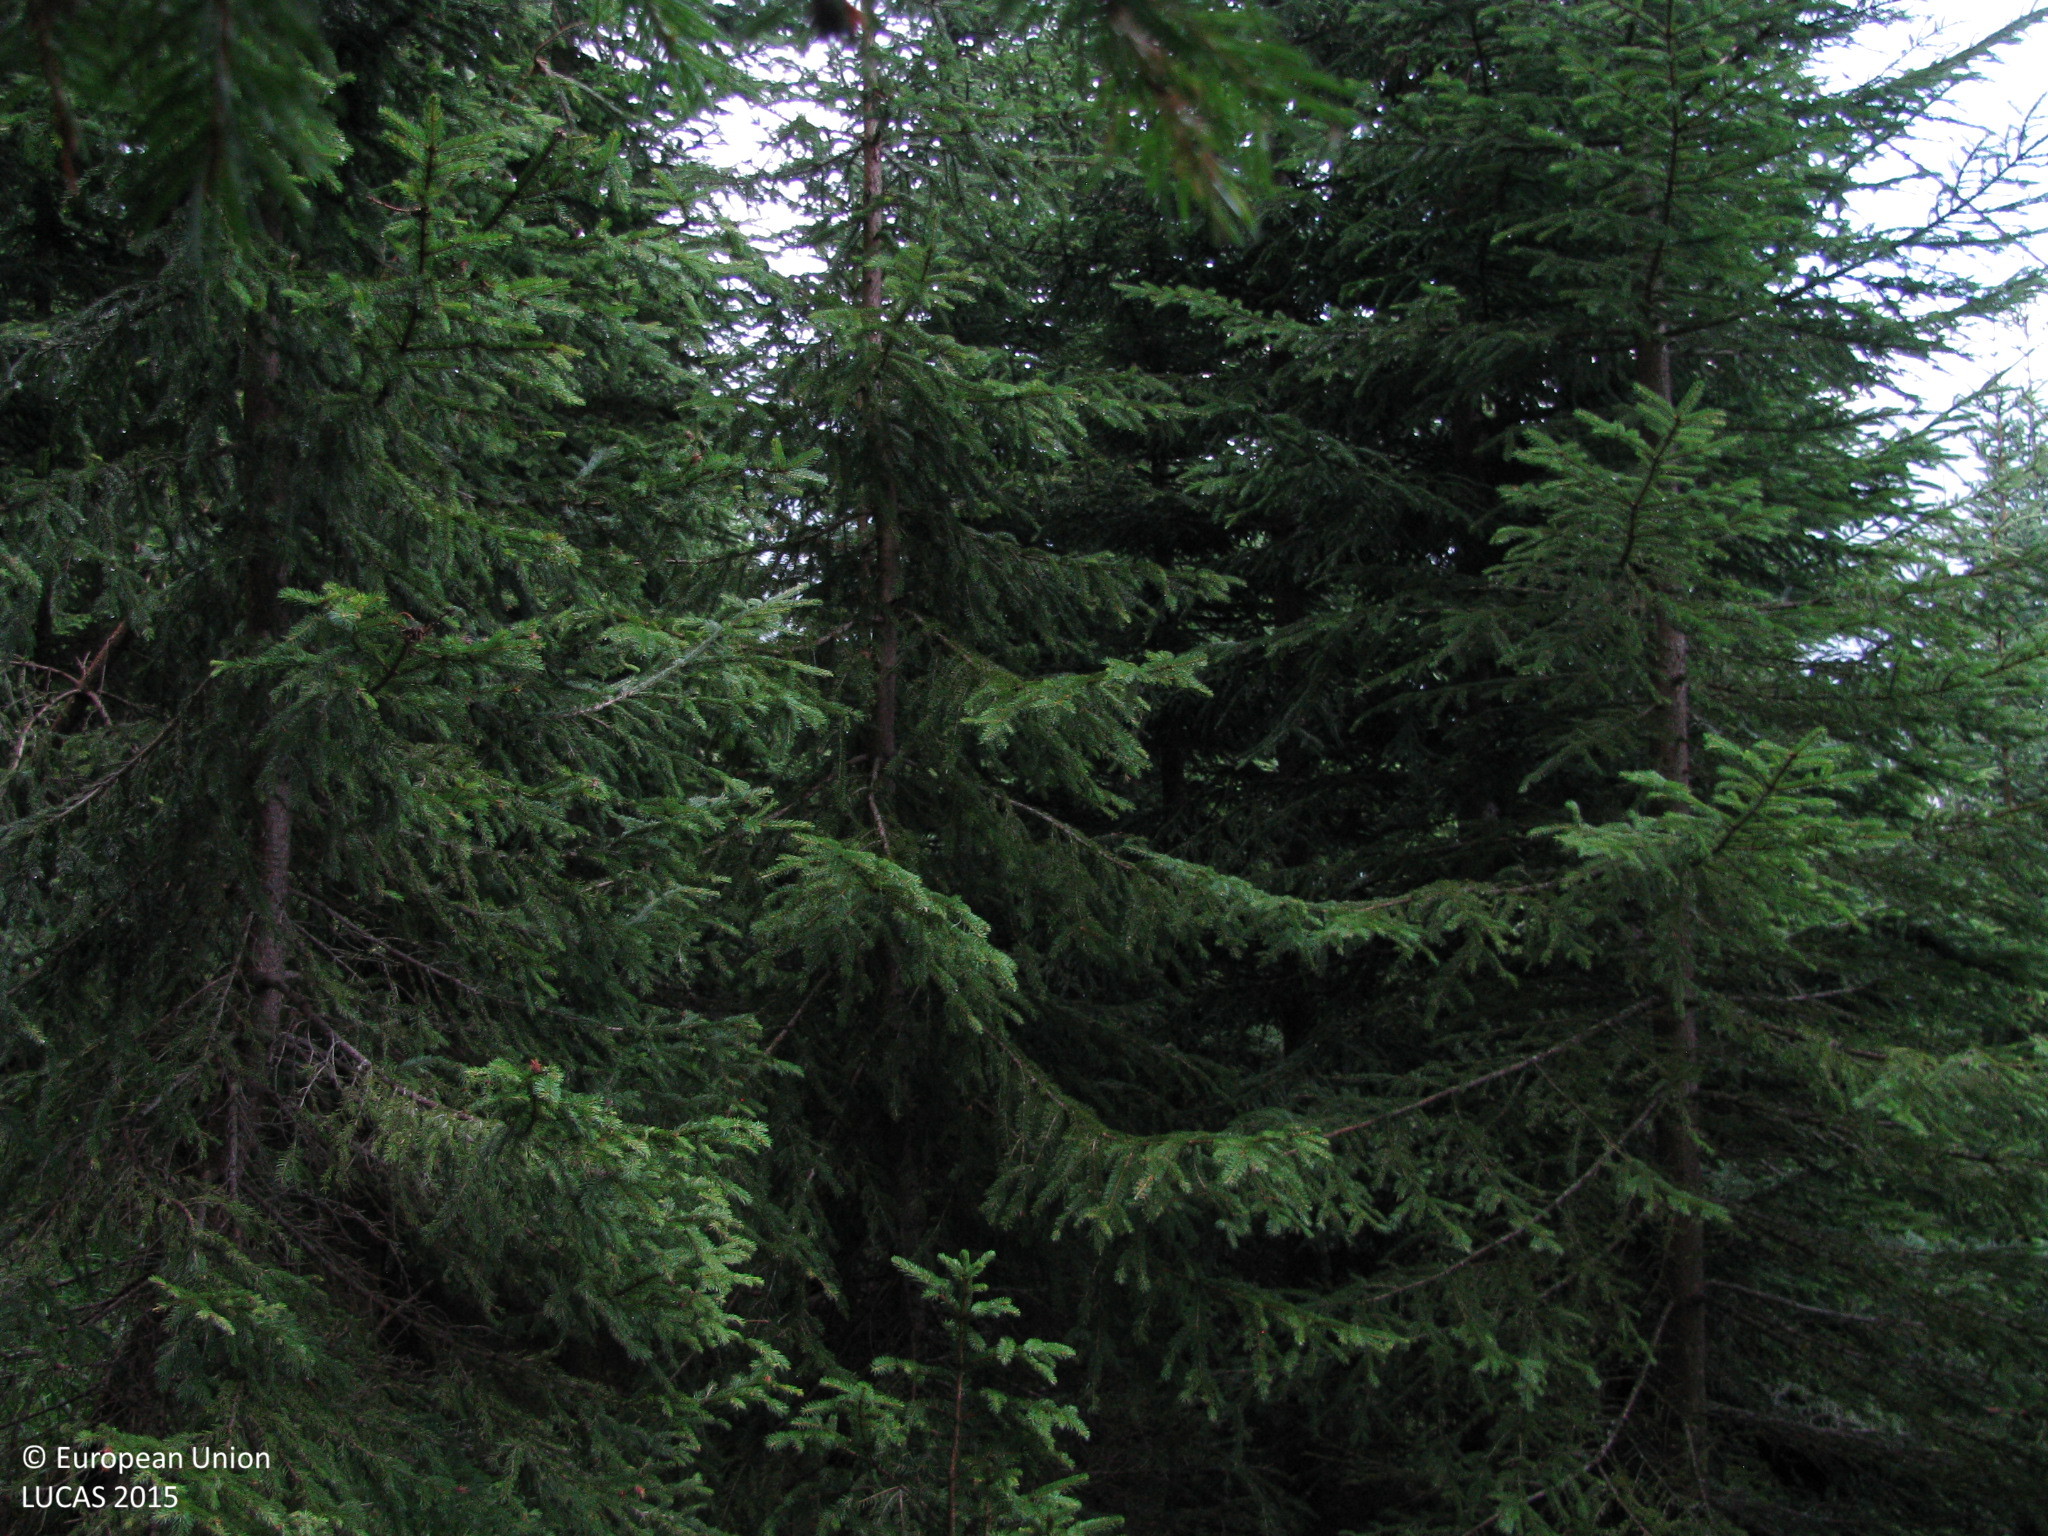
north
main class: Woodland
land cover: Spruce dominated coniferous woodland
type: alpine coniferous forest
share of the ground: > 75 %
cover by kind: coniferous forest trees 85 %, herbaceous plants 15 %
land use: Forestry
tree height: > 5 m
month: July
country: AT
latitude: 46.6974
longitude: 12.6261
